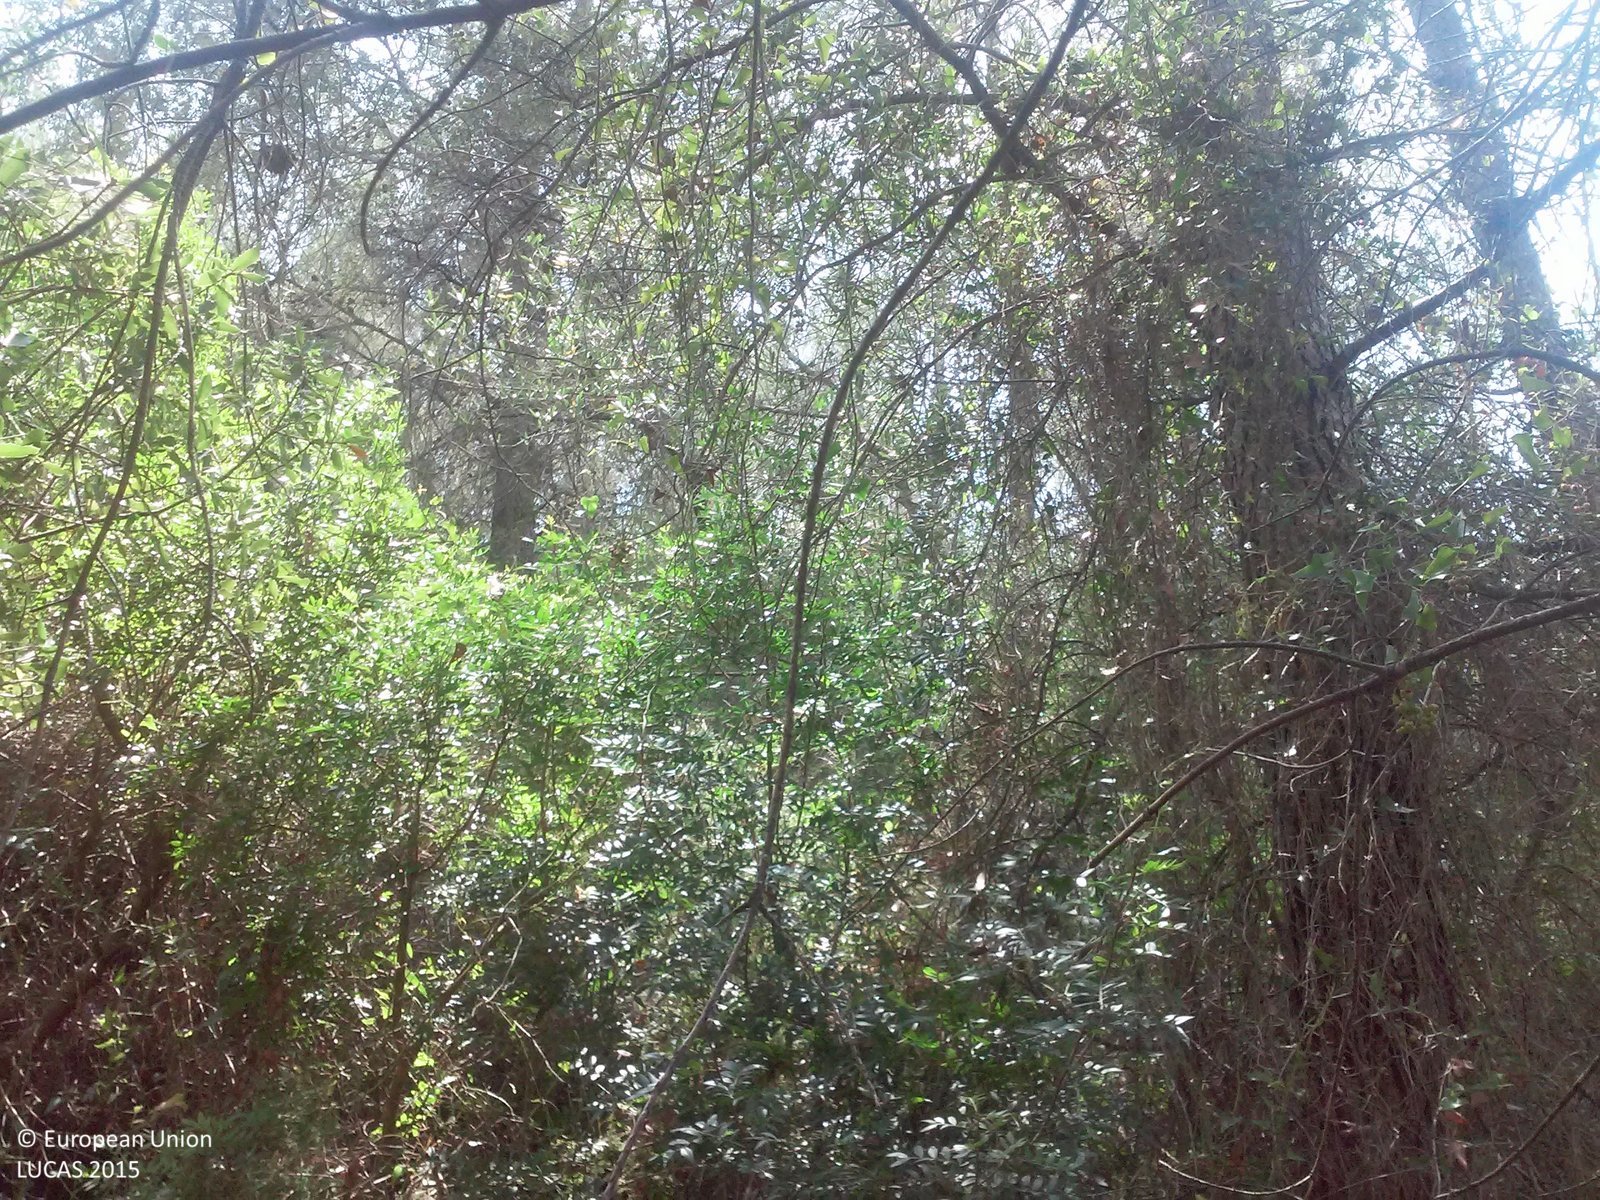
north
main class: Woodland
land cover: Pine dominated coniferous woodland
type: coniferous forest of the mediterranean region
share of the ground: > 75 %
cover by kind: coniferous forest trees 80 %, herbaceous plants 10 %, broadleaved forest trees 5 %, shrubs 5 %
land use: Semi-natural and natural areas not in use
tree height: > 5 m
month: July
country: ES
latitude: 41.1494
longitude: 1.2597
